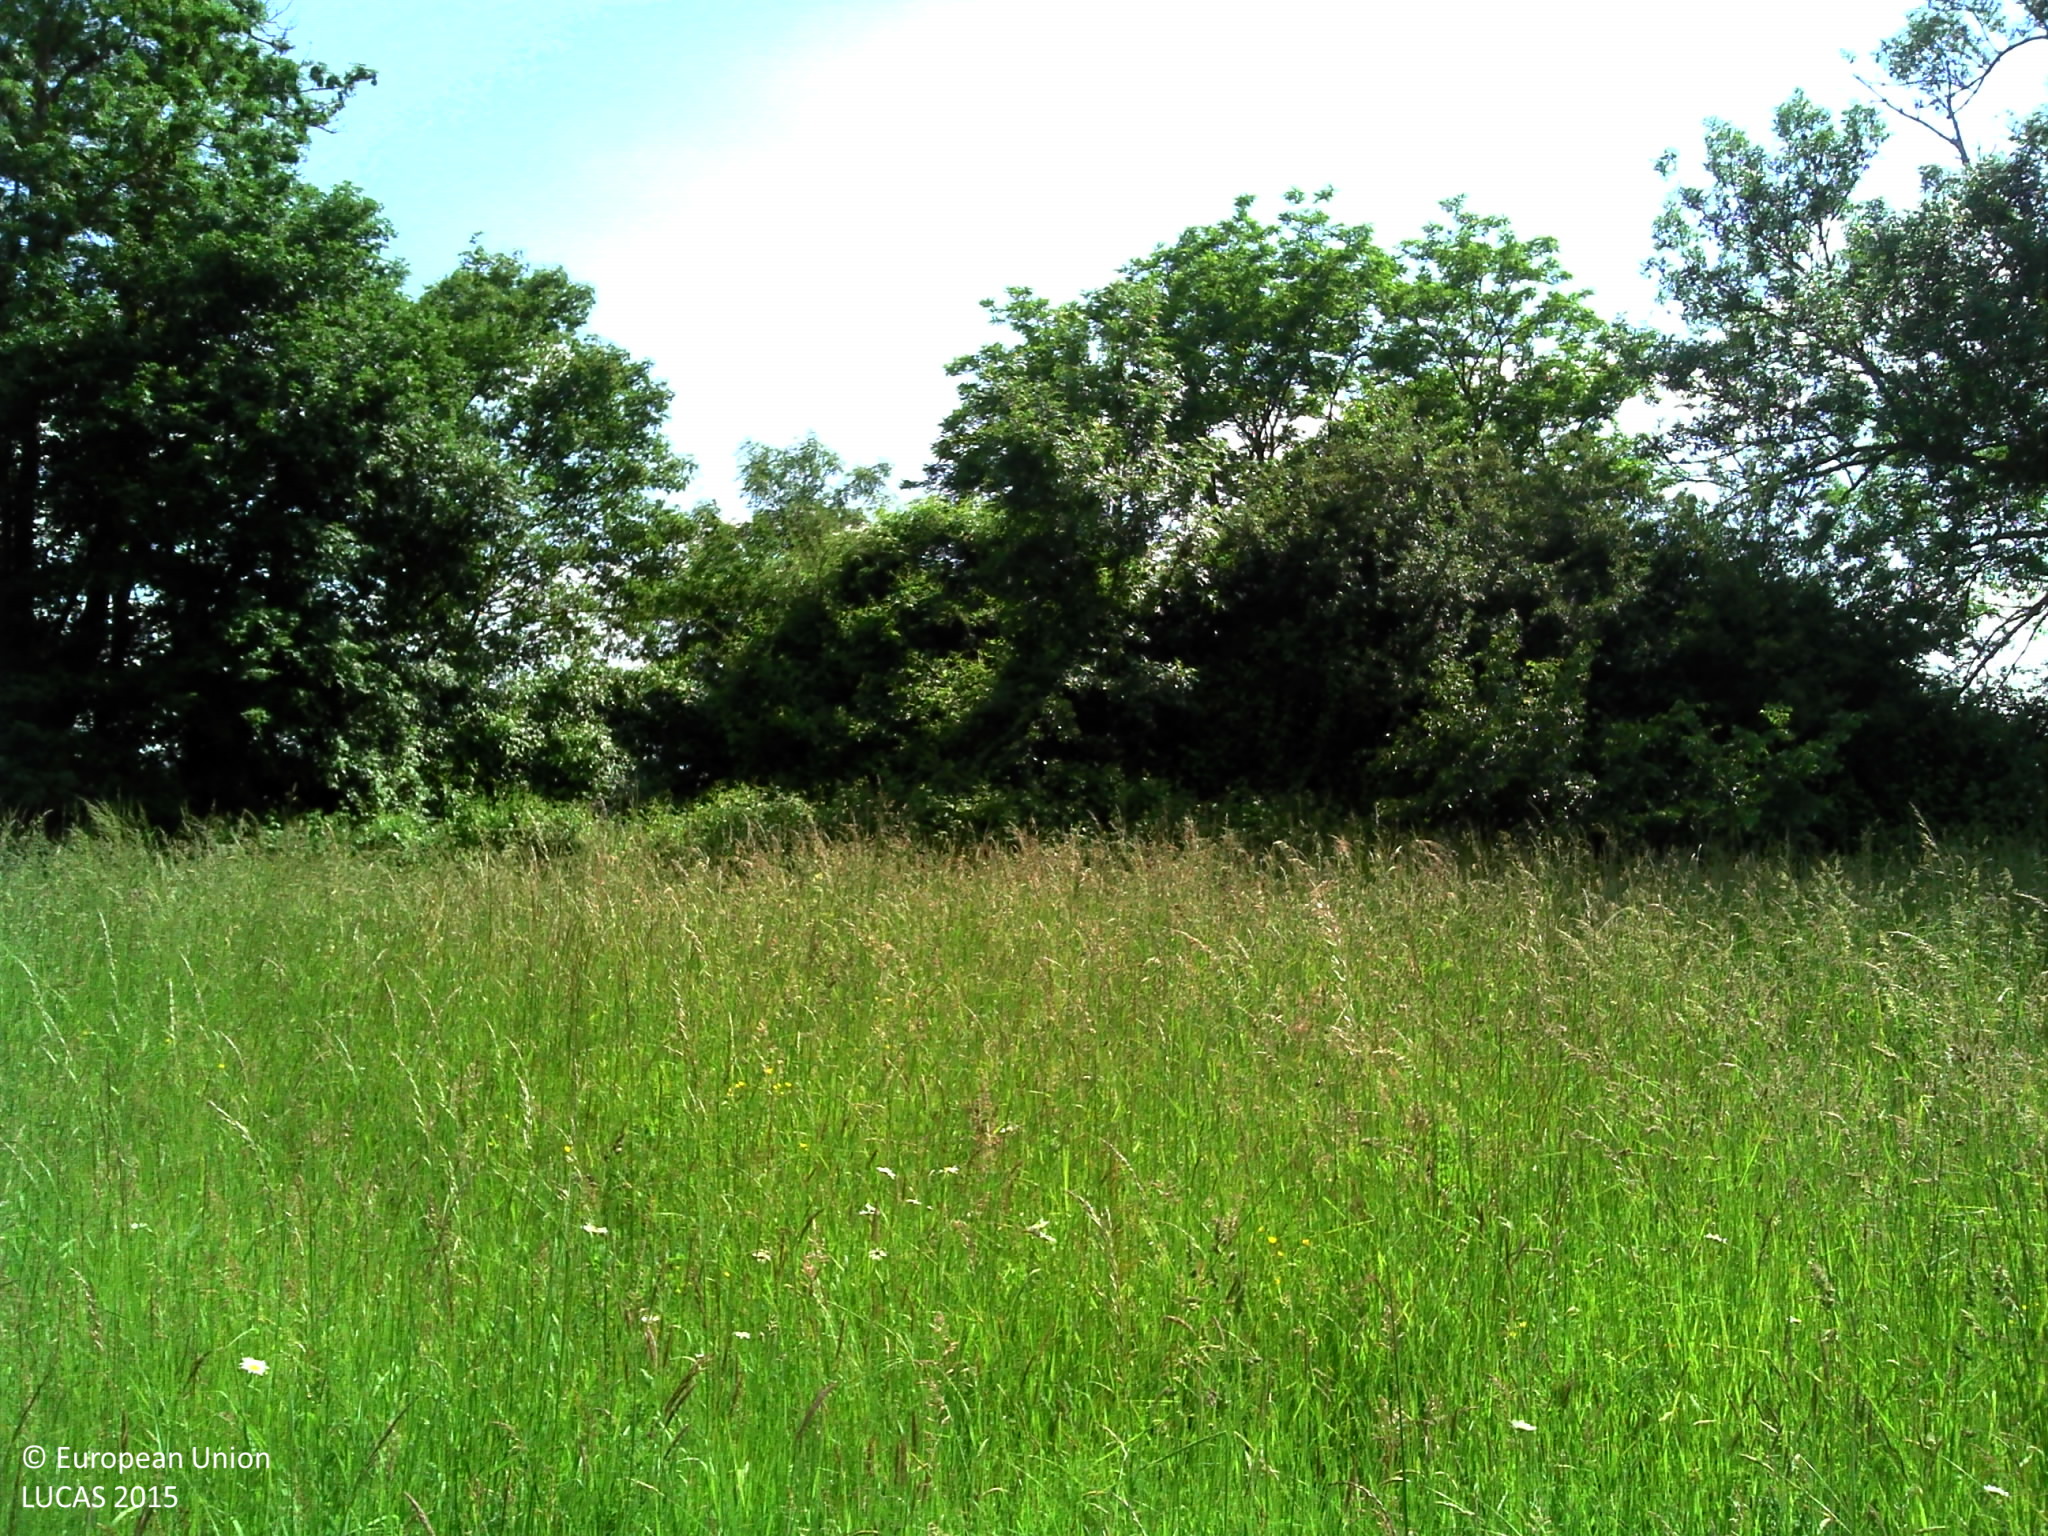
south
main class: Grassland
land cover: Grassland without tree/shrub cover
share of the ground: > 75 %
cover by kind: herbaceous plants 100 %
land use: Agriculture (excluding fallow land and kitchen gardens)
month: May
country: FR
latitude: 47.2912
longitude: 2.9202
